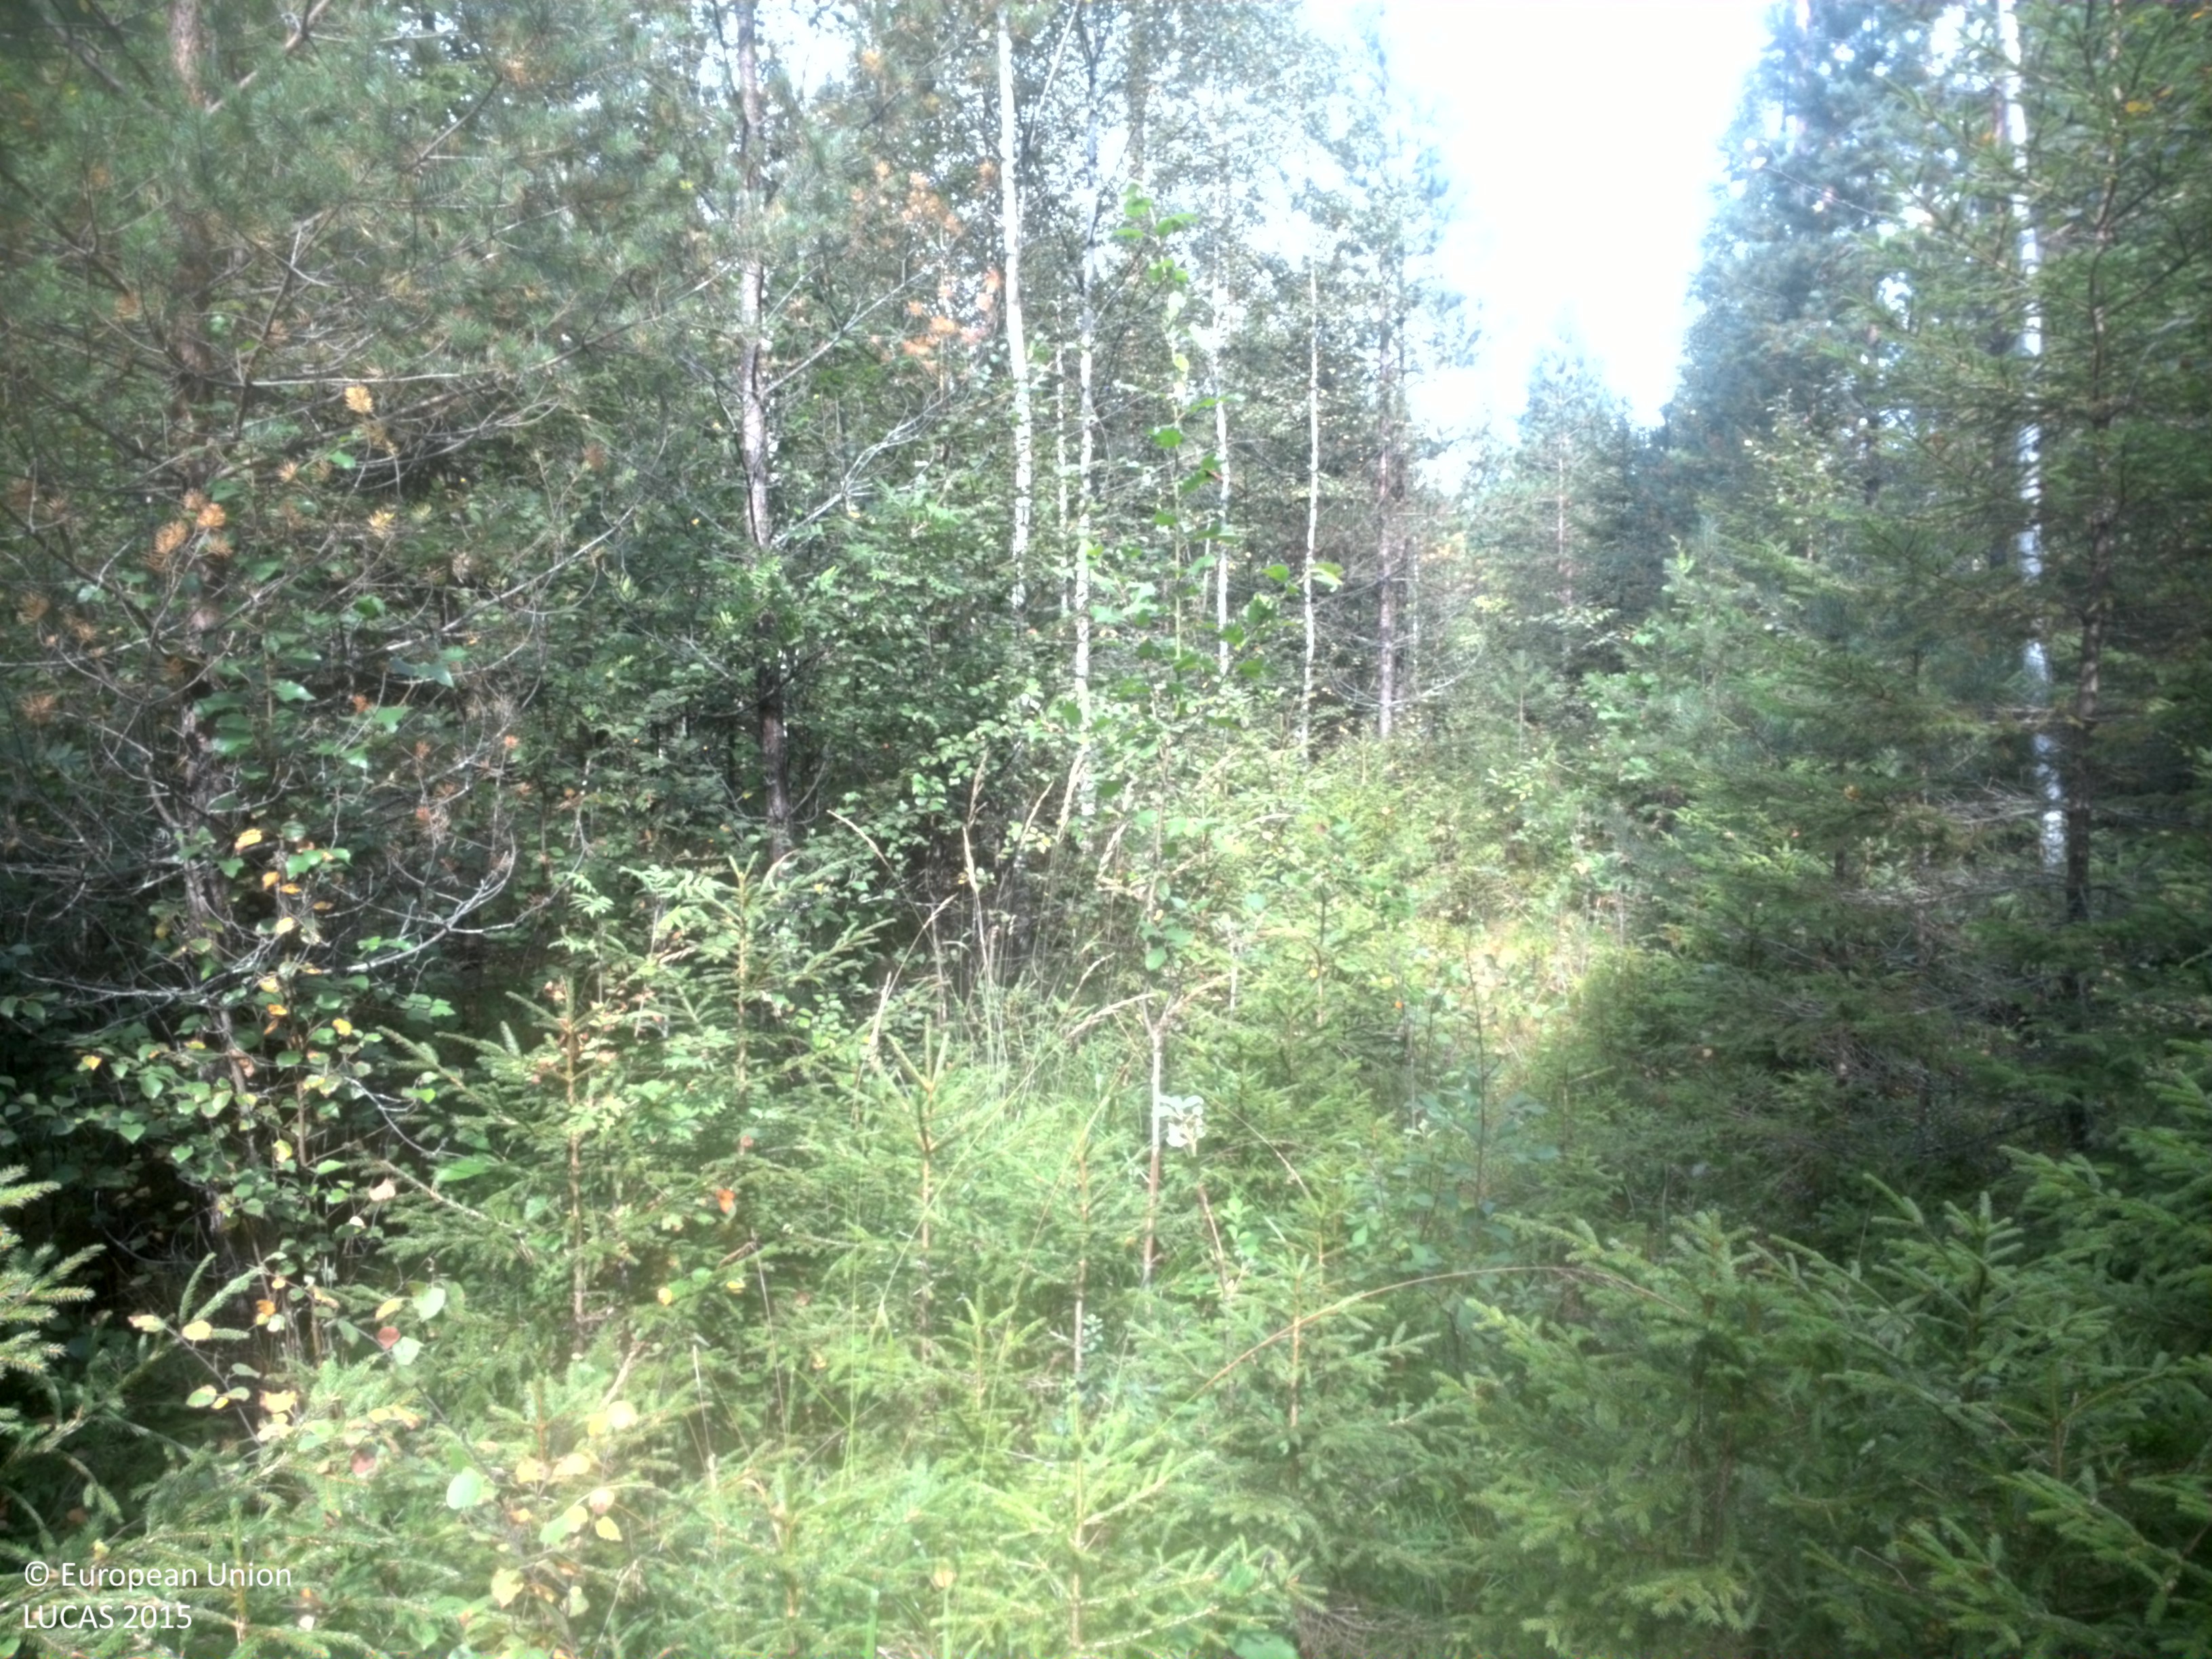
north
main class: Woodland
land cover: Spruce dominated mixed woodland
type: boreal forest
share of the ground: > 75 %
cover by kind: coniferous forest trees 50 %, broadleaved forest trees 25 %, shrubs 10 %, herbaceous plants 10 %, lichens and mosses 5 %
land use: Forestry
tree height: > 5 m
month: August
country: SE
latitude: 59.7420
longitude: 15.6660
